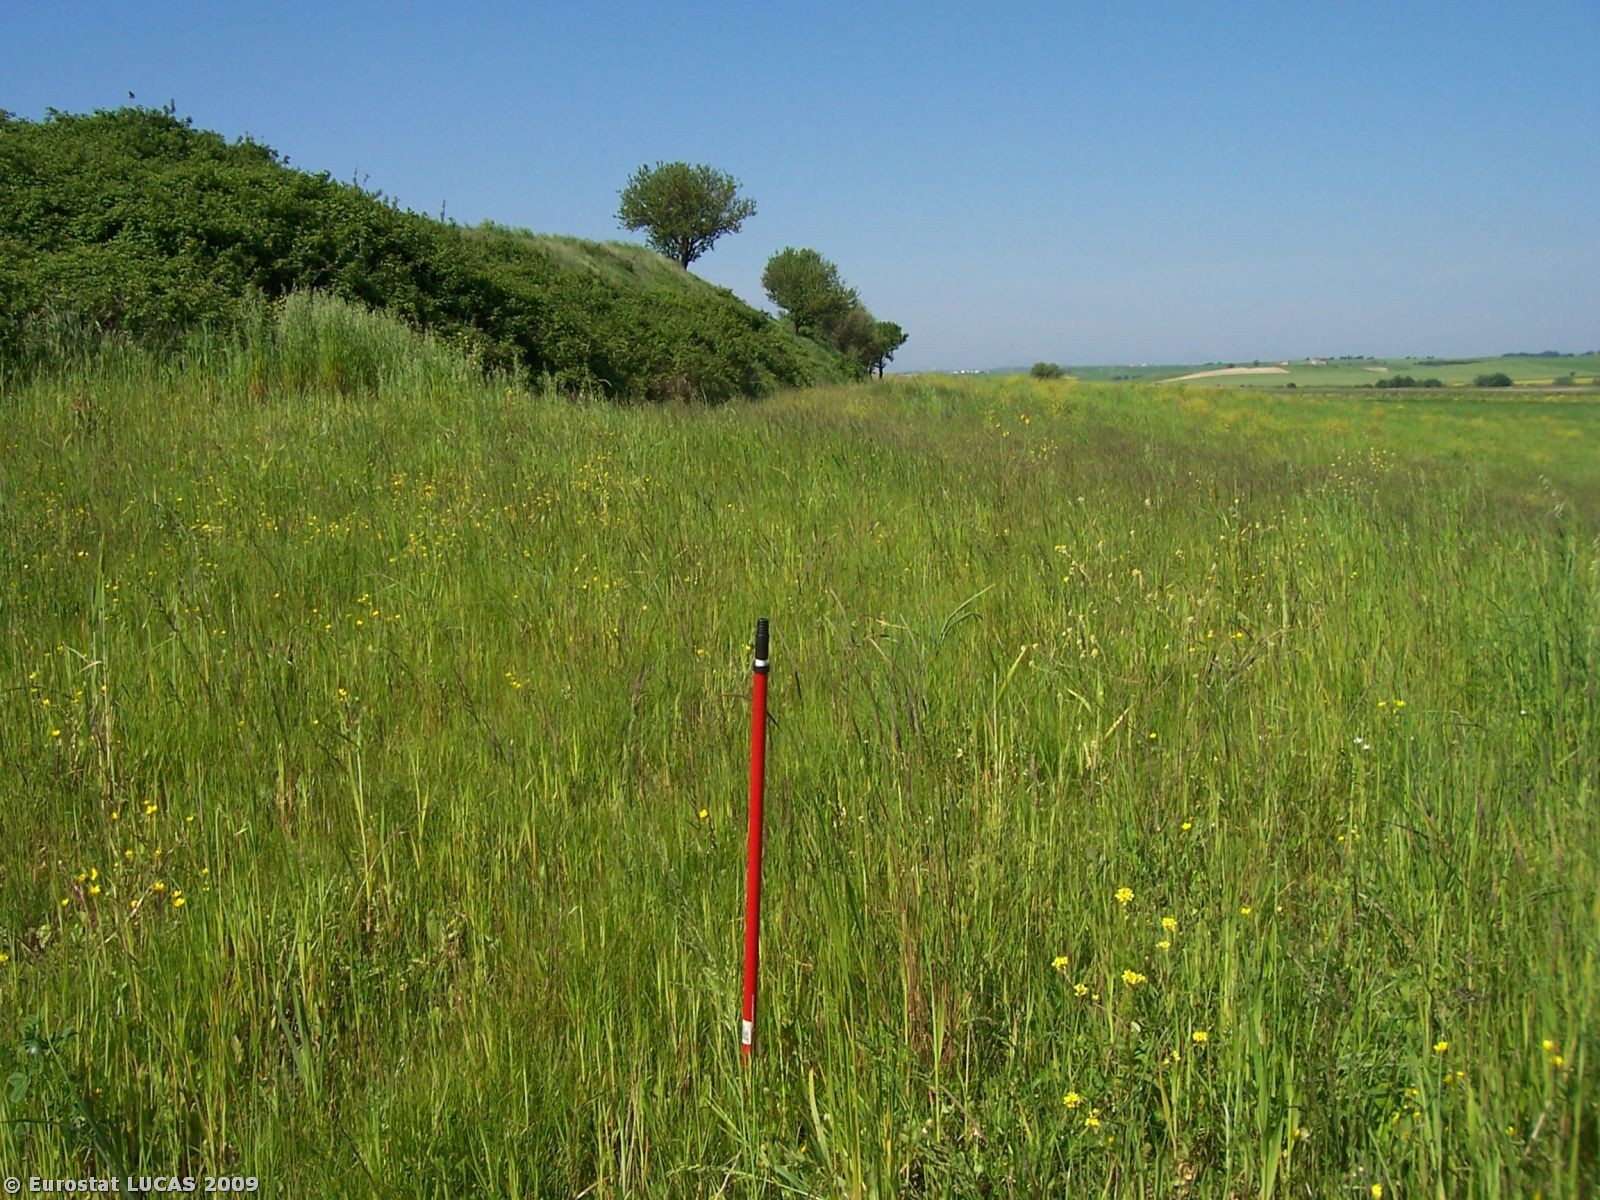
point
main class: Cropland
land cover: Mixed cereals for fodder
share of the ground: > 75 %
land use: Agriculture (excluding fallow land and kitchen gardens)
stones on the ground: < 10 %
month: May
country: IT
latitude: 40.6762
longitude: 16.9215
